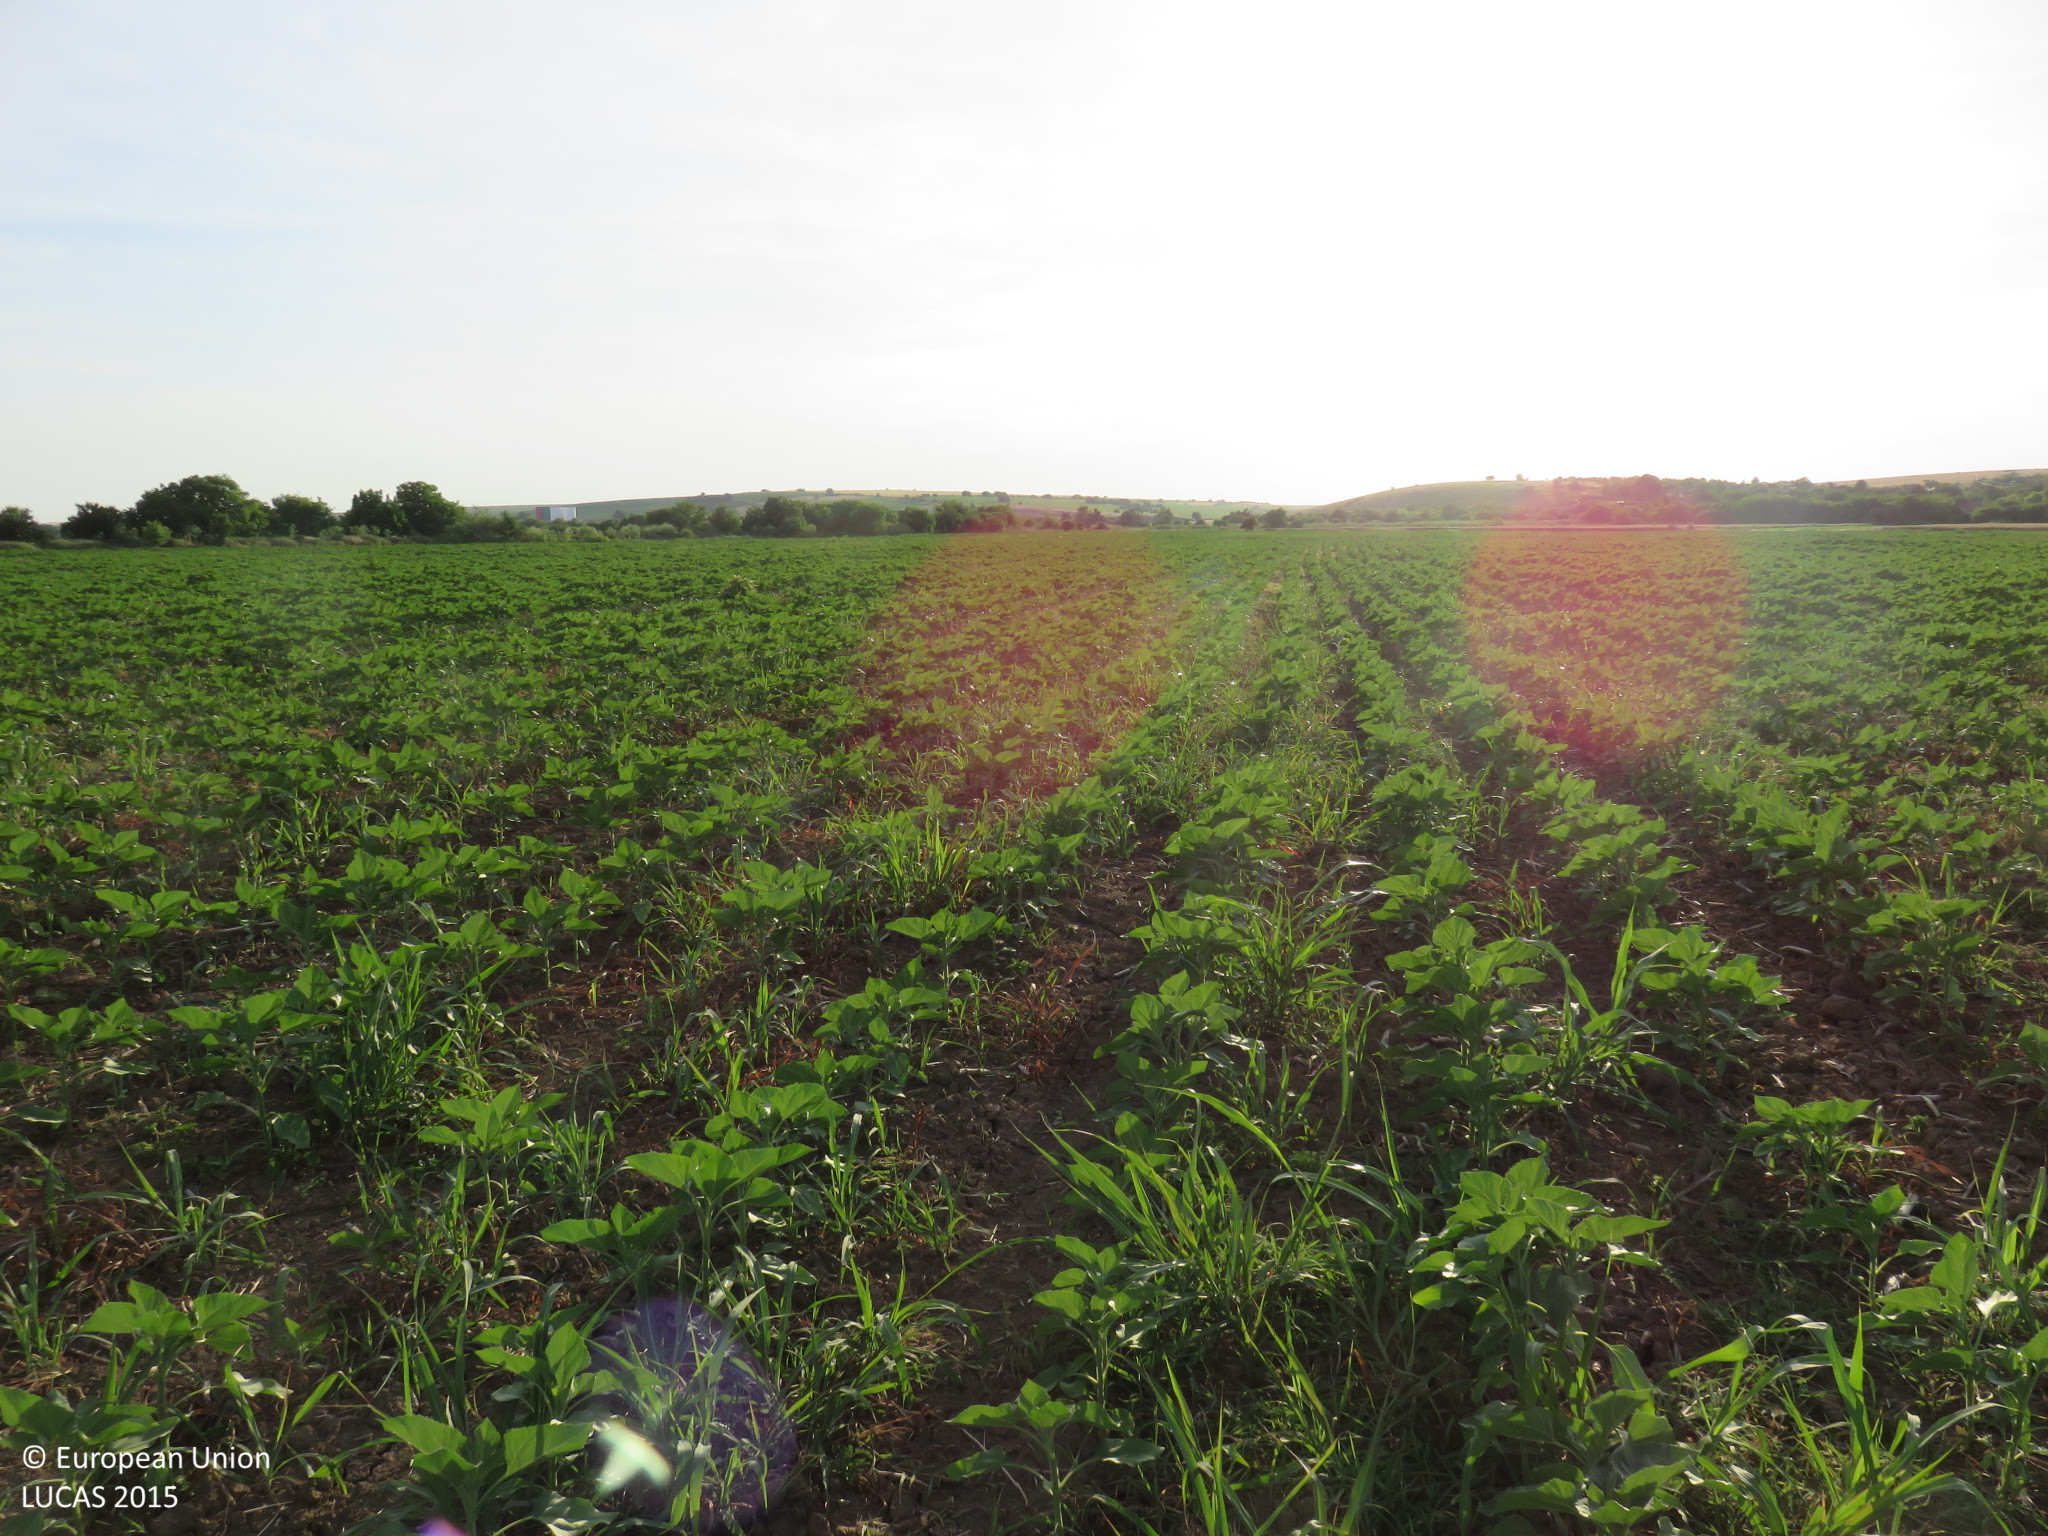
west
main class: Cropland
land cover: Sunflower
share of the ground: > 75 %
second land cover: Spontaneously vegetated surfaces
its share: 10 - 25 %
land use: Agriculture (excluding fallow land and kitchen gardens)
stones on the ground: < 10 %
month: June
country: BG
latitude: 43.6326
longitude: 24.4017
